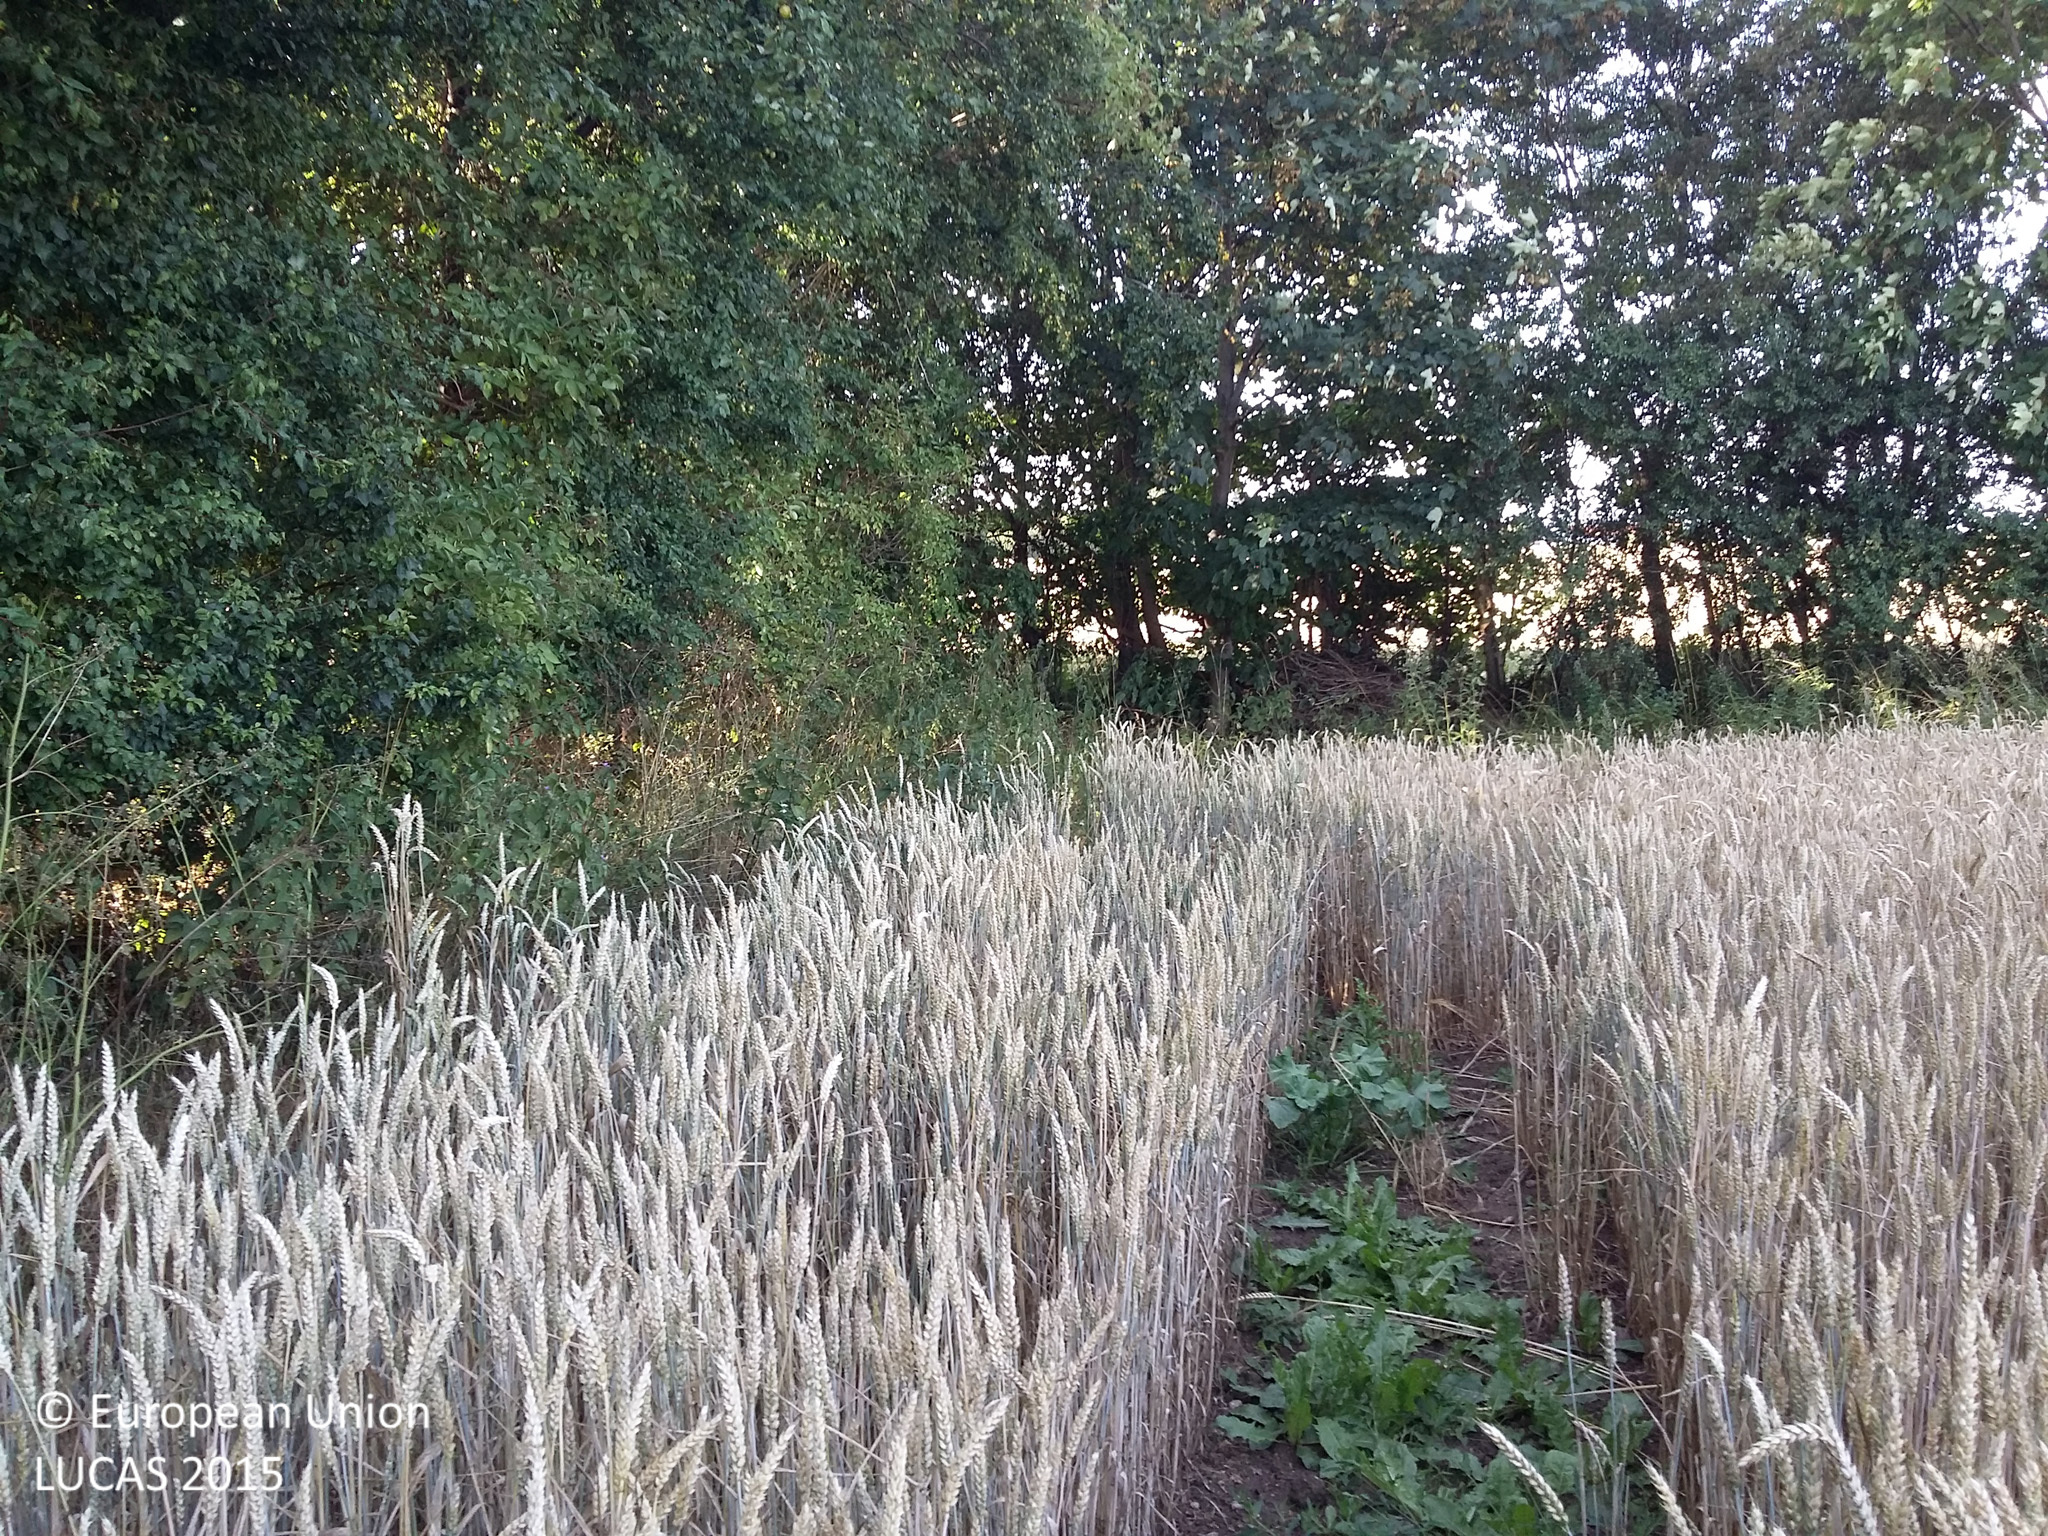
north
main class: Cropland
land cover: Common wheat
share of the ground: > 75 %
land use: Agriculture (excluding fallow land and kitchen gardens)
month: August
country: DK
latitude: 55.3576
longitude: 12.3171
